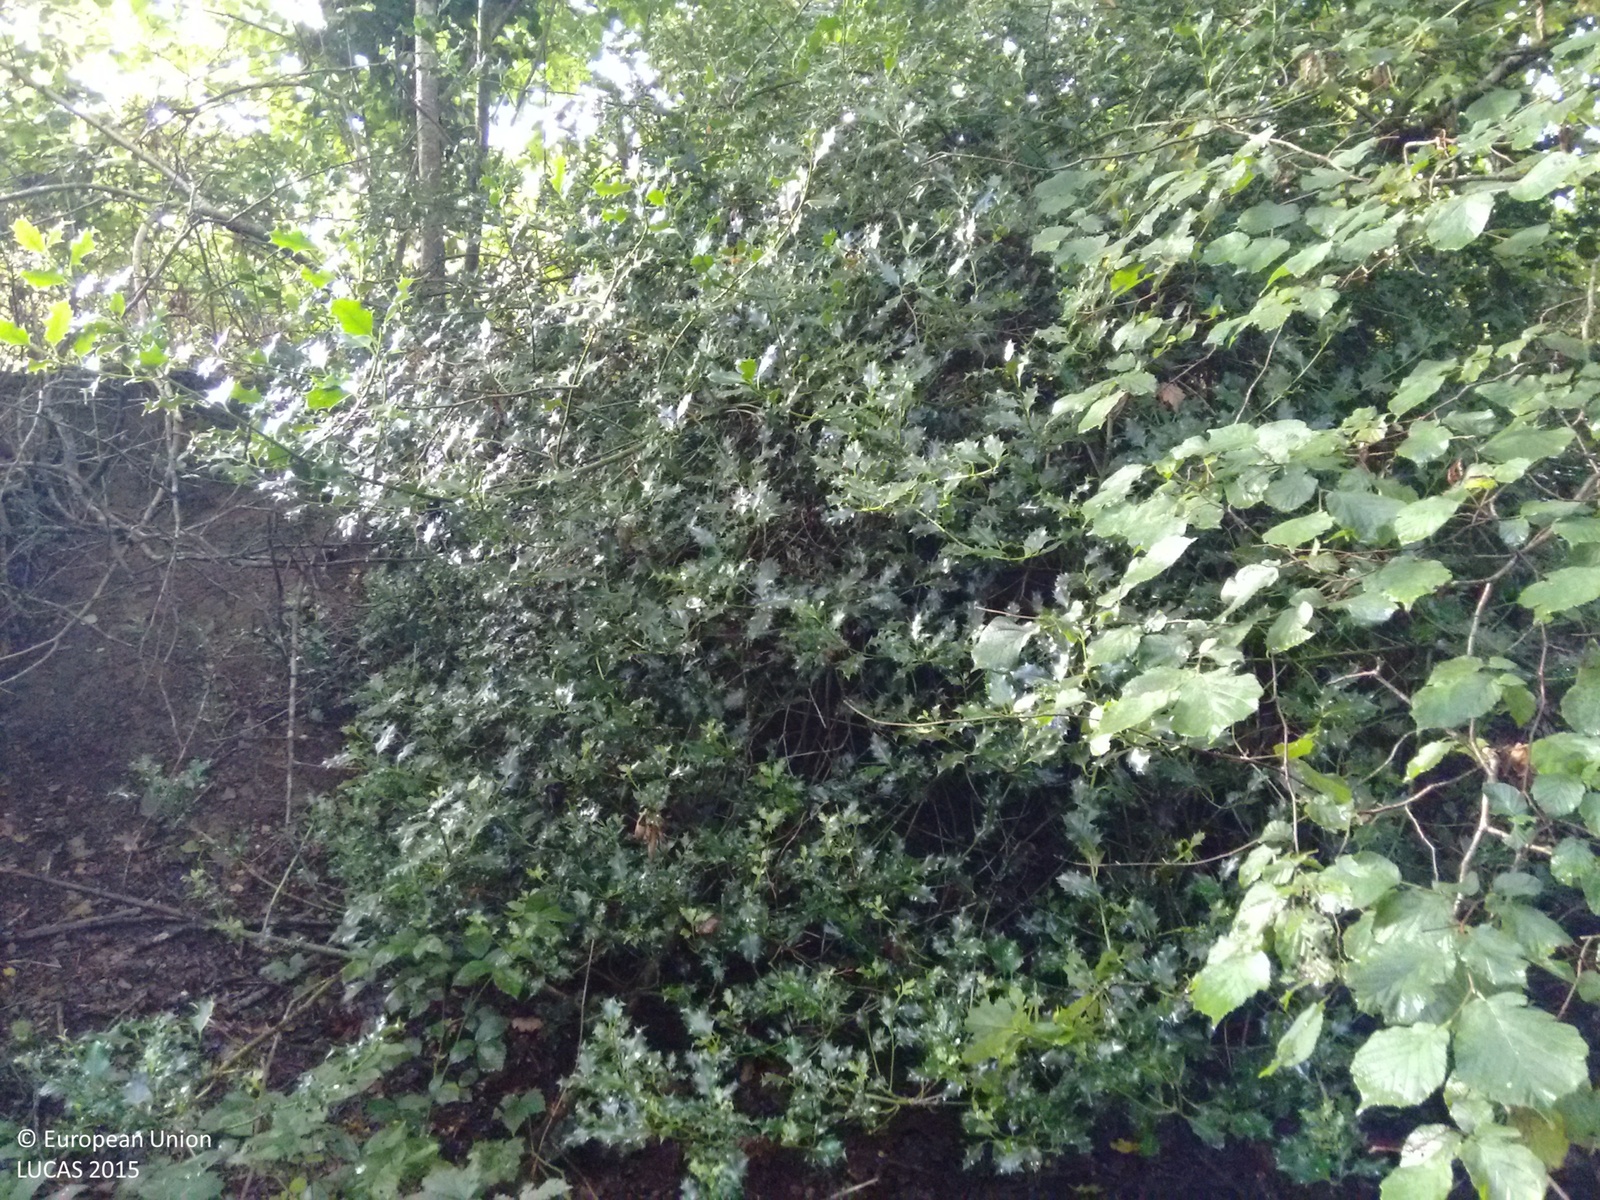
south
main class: Woodland
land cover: Broadleaved woodland
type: mesophytic deciduous forest
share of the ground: > 75 %
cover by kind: broadleaved forest trees 100 %
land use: Semi-natural and natural areas not in use
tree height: > 5 m
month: September
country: GB
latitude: 50.6769
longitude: -4.3518
